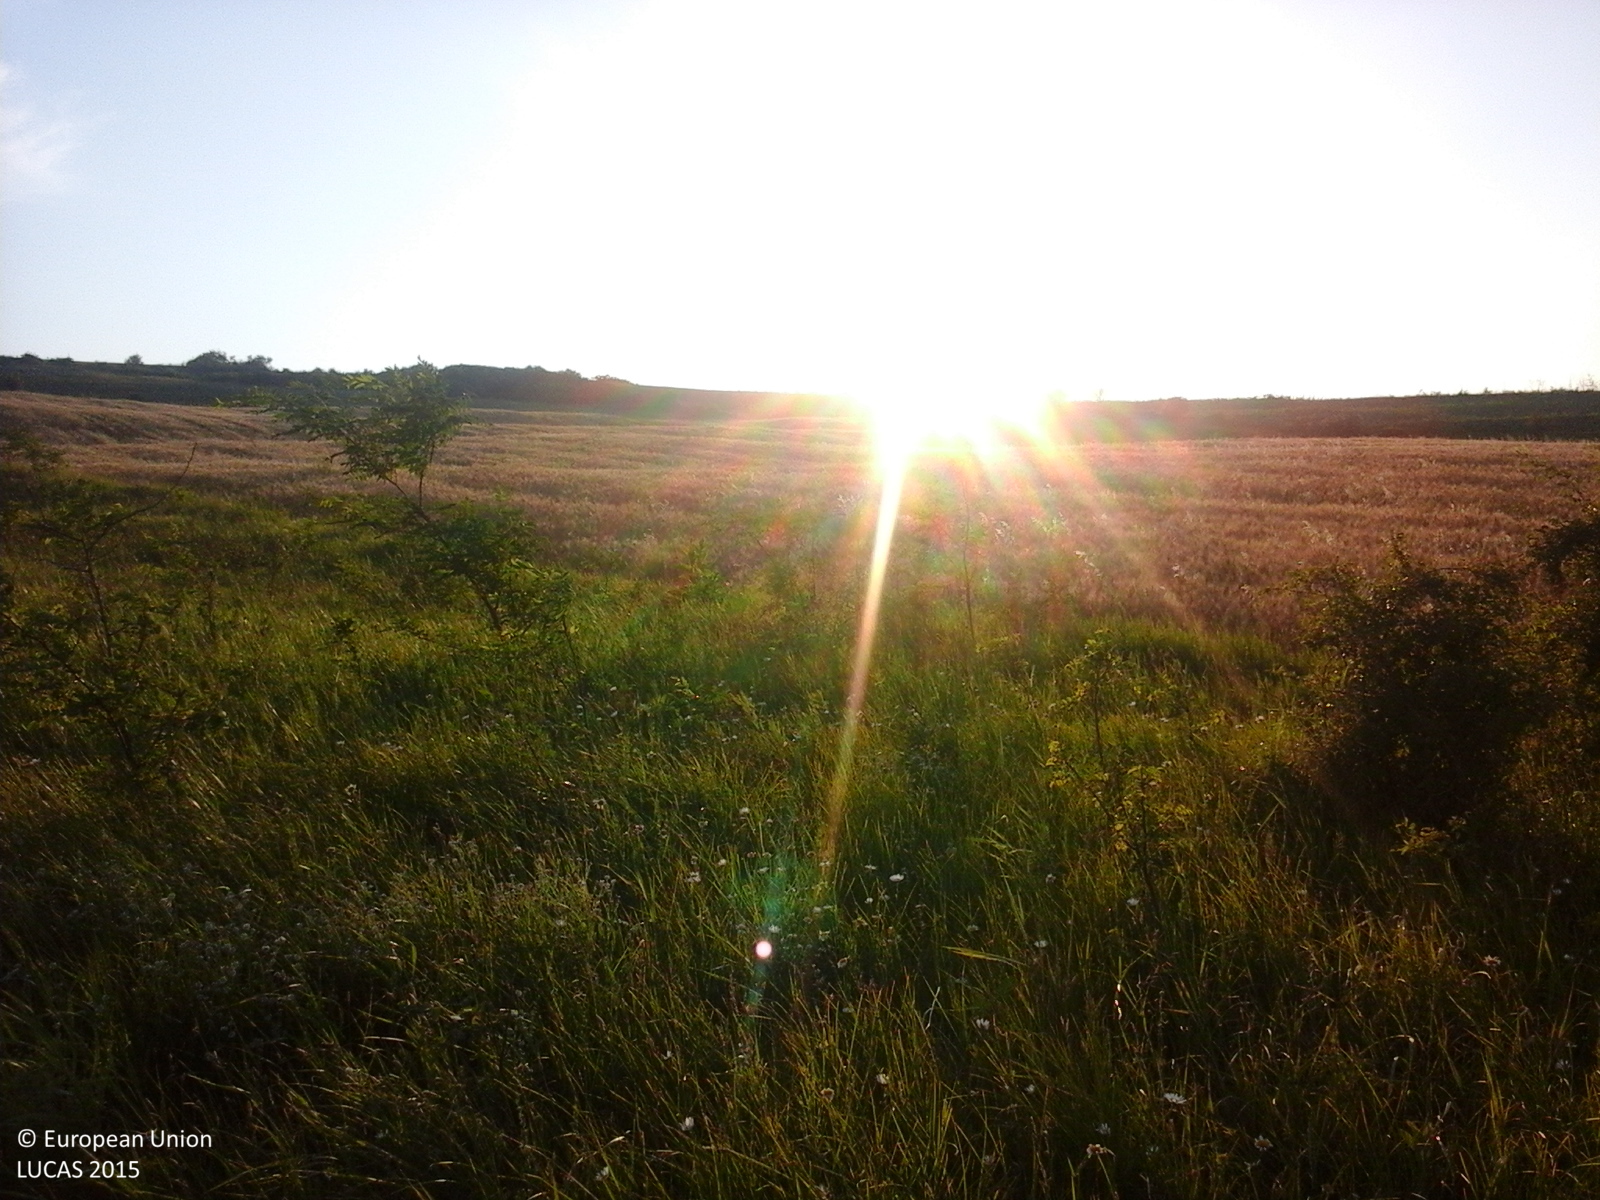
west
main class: Grassland
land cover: Grassland with sparse tree/shrub cover
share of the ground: > 75 %
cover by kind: herbaceous plants 90 %, broadleaved forest trees 5 %, shrubs 5 %
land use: Agriculture (excluding fallow land and kitchen gardens)
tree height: < 5 m
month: June
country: RO
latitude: 46.6690
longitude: 27.4556
